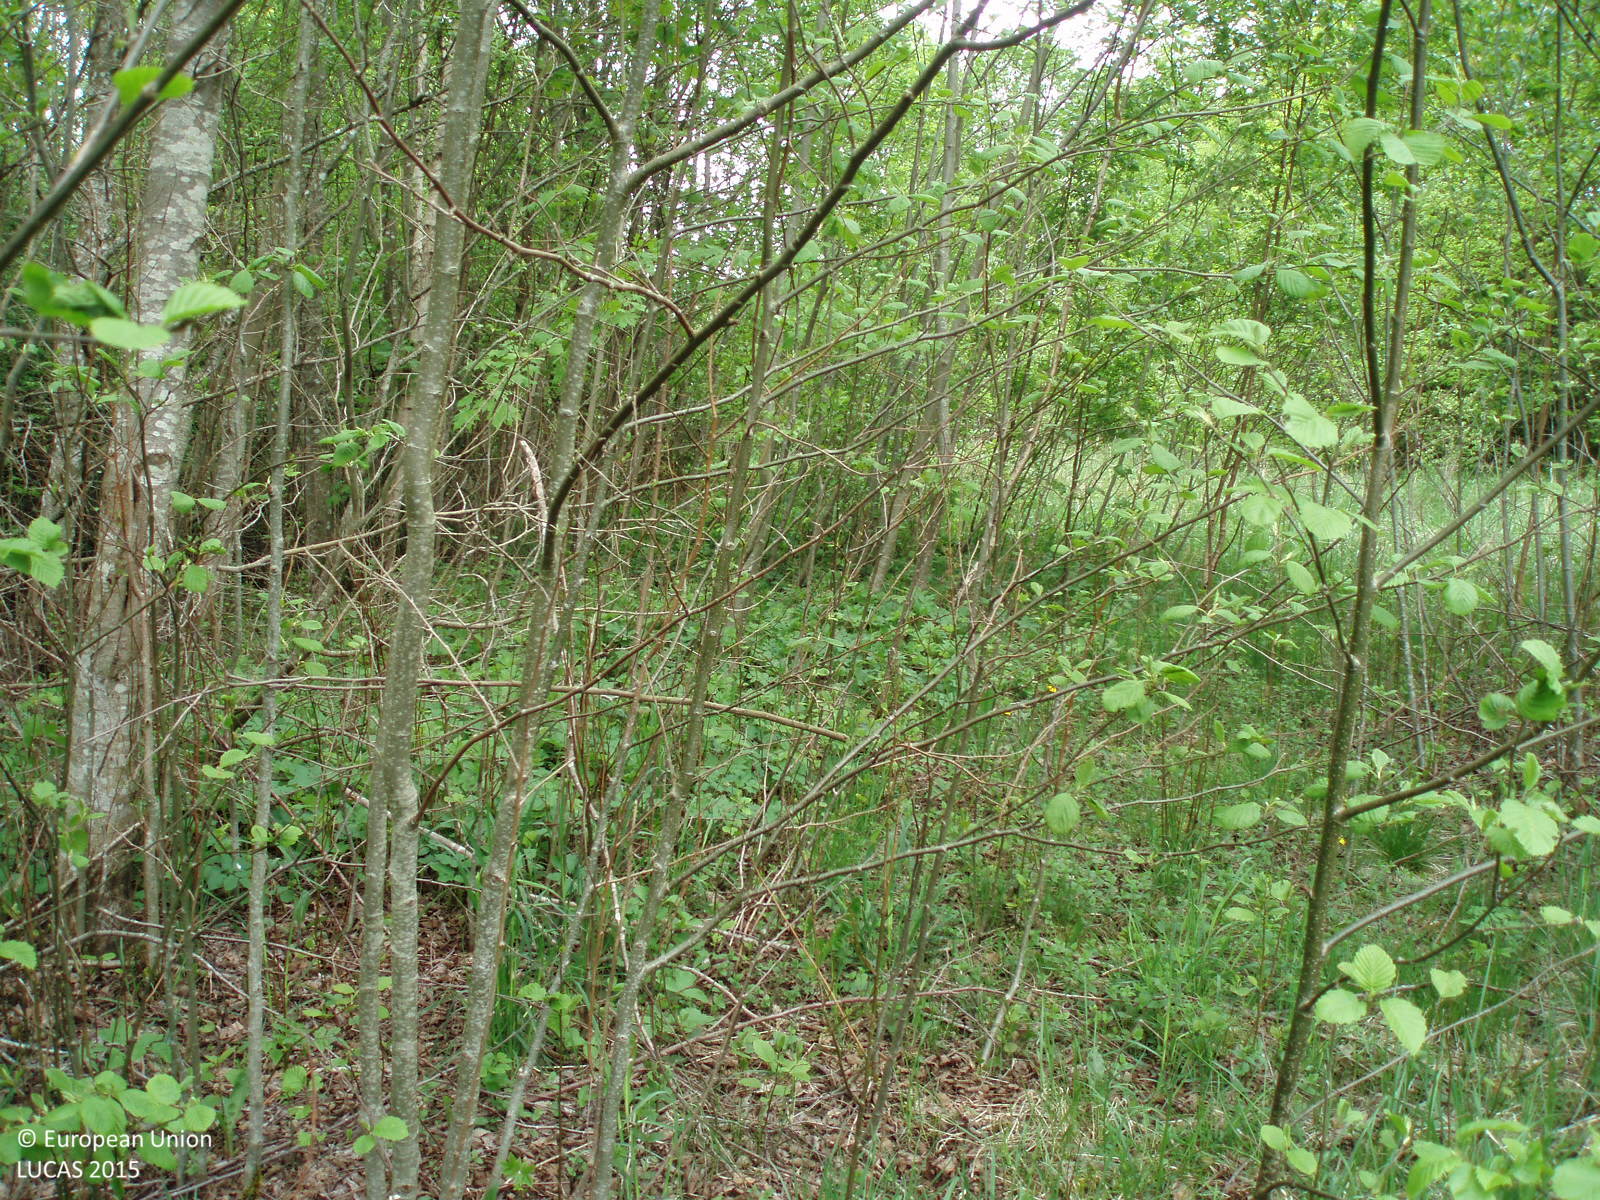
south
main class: Grassland
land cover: Spontaneously vegetated surfaces
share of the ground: > 75 %
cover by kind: herbaceous plants 100 %
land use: Semi-natural and natural areas not in use
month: May
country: LT
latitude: 56.3275
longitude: 22.4283
